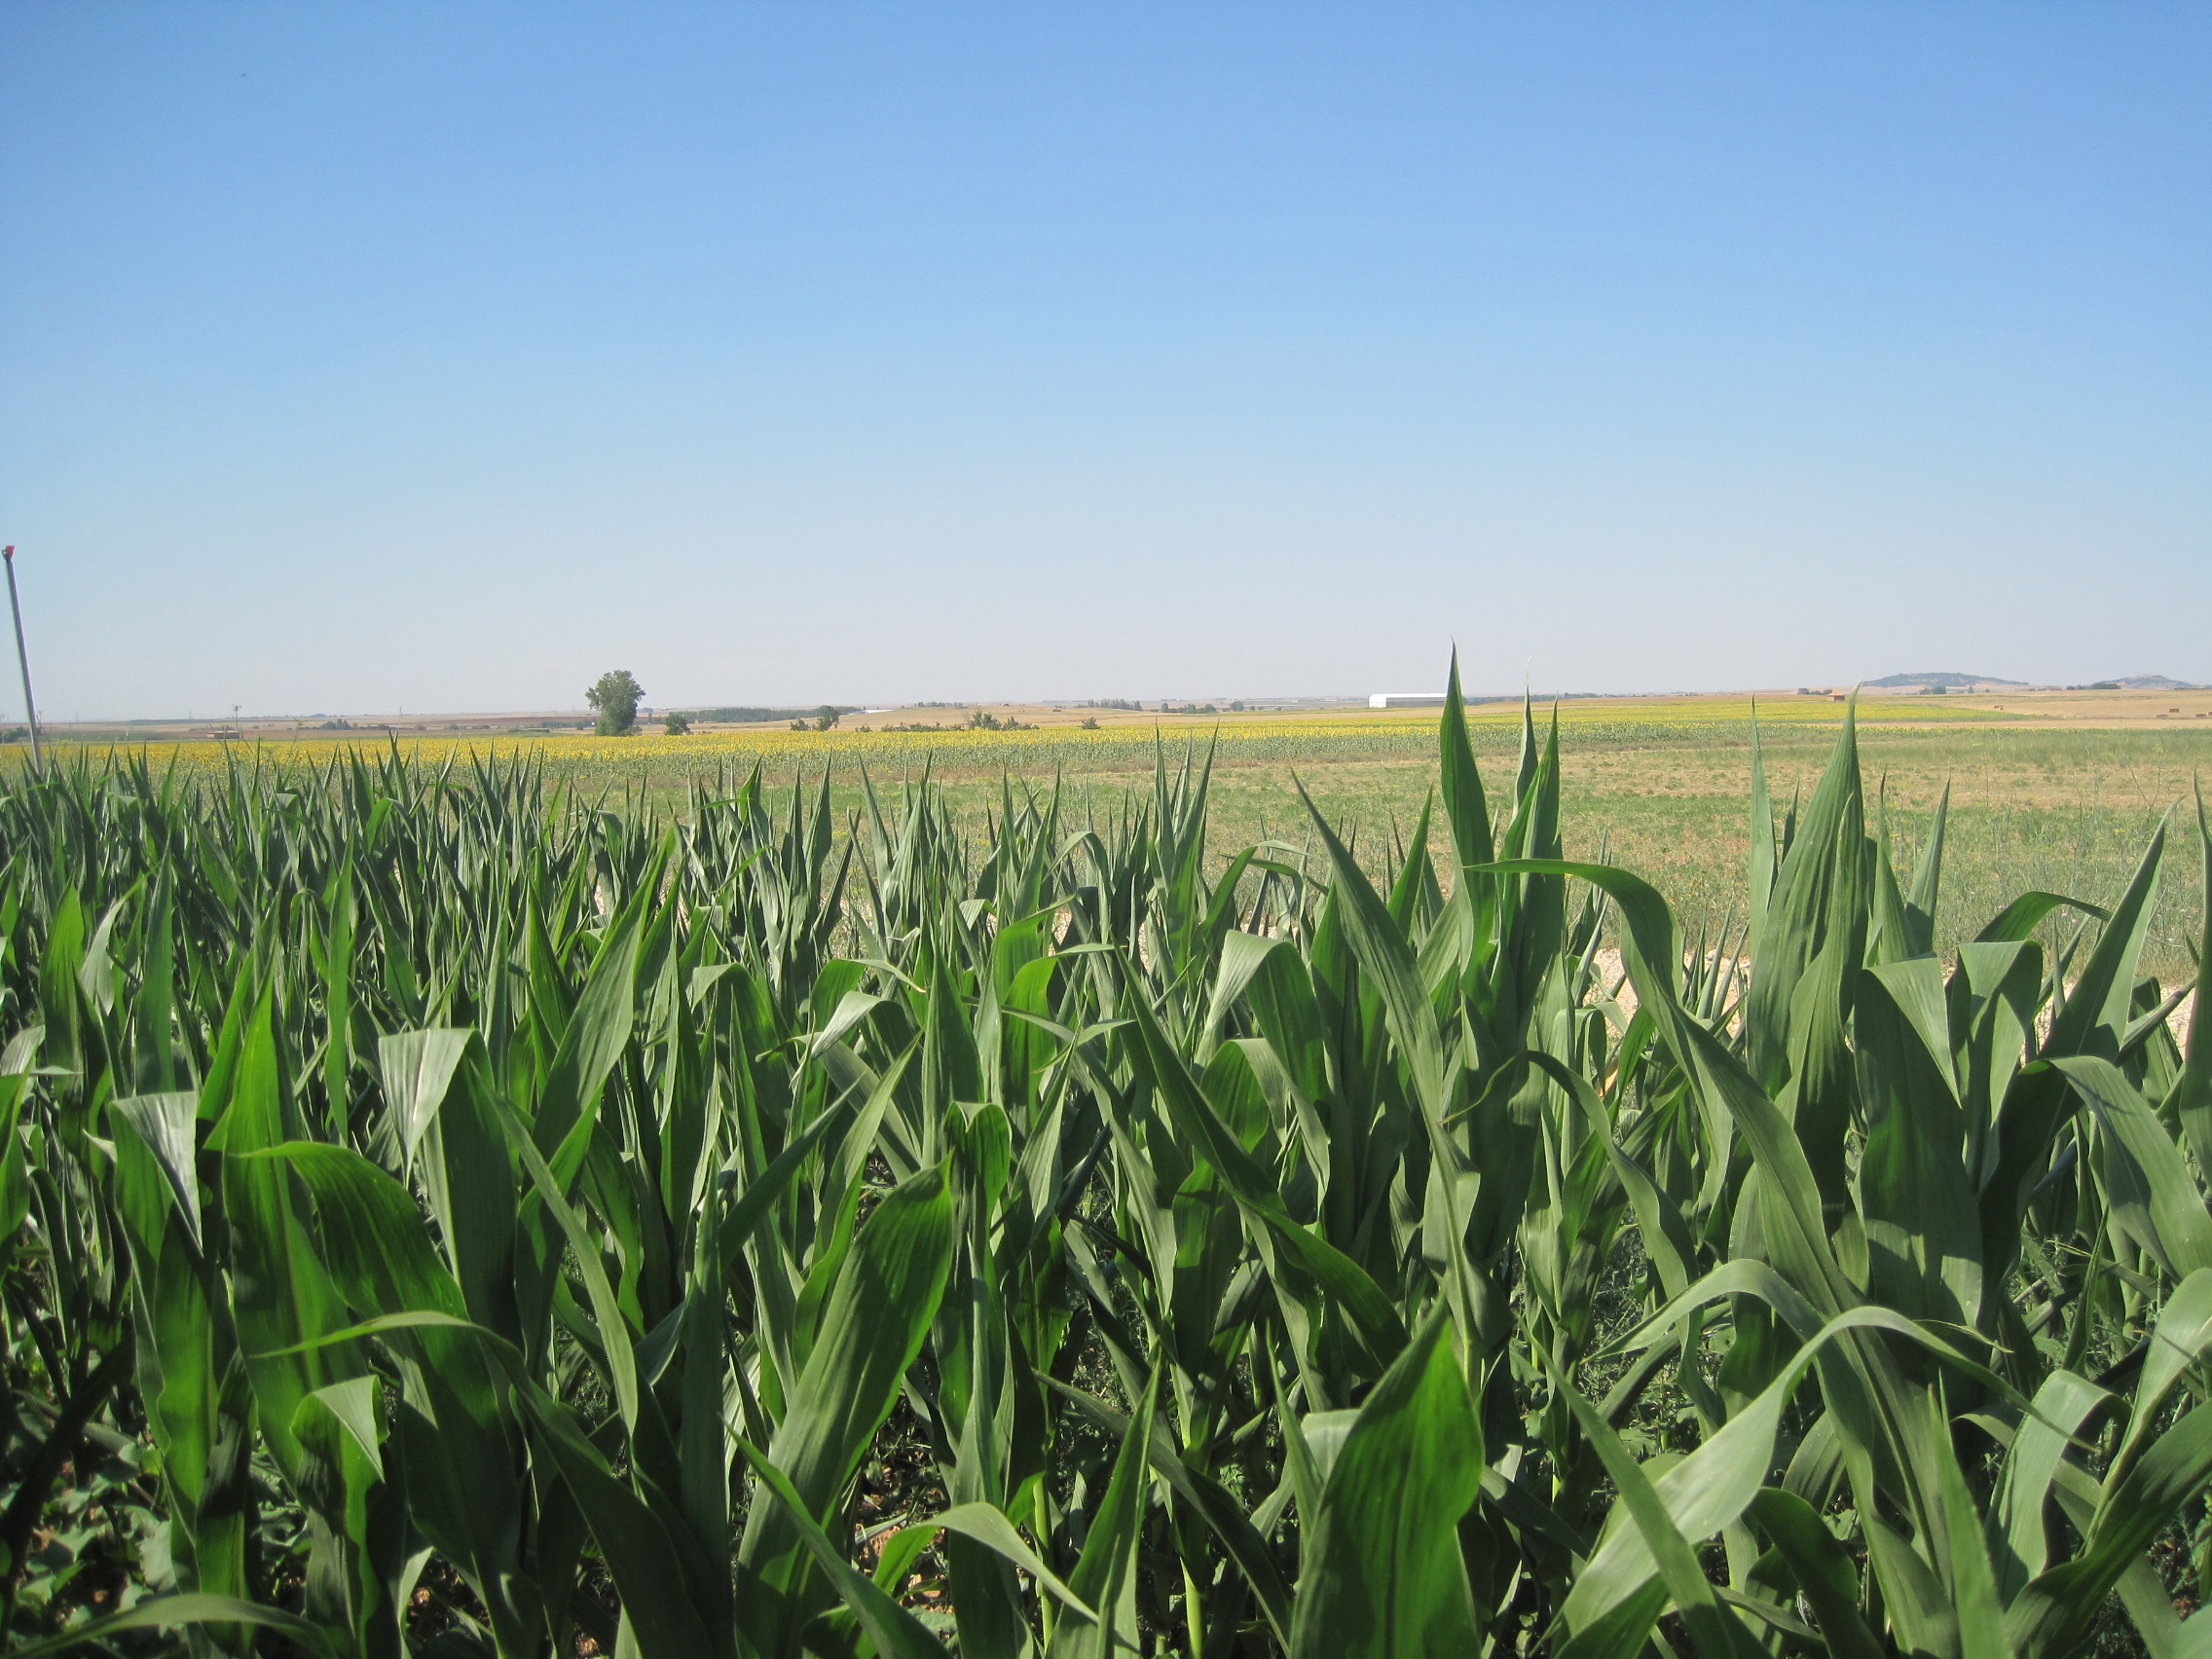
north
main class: Cropland
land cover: Maize
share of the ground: > 75 %
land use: Agriculture (excluding fallow land and kitchen gardens)
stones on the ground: 10 - 25 %
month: July
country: ES
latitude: 41.7351
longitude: -5.2162
